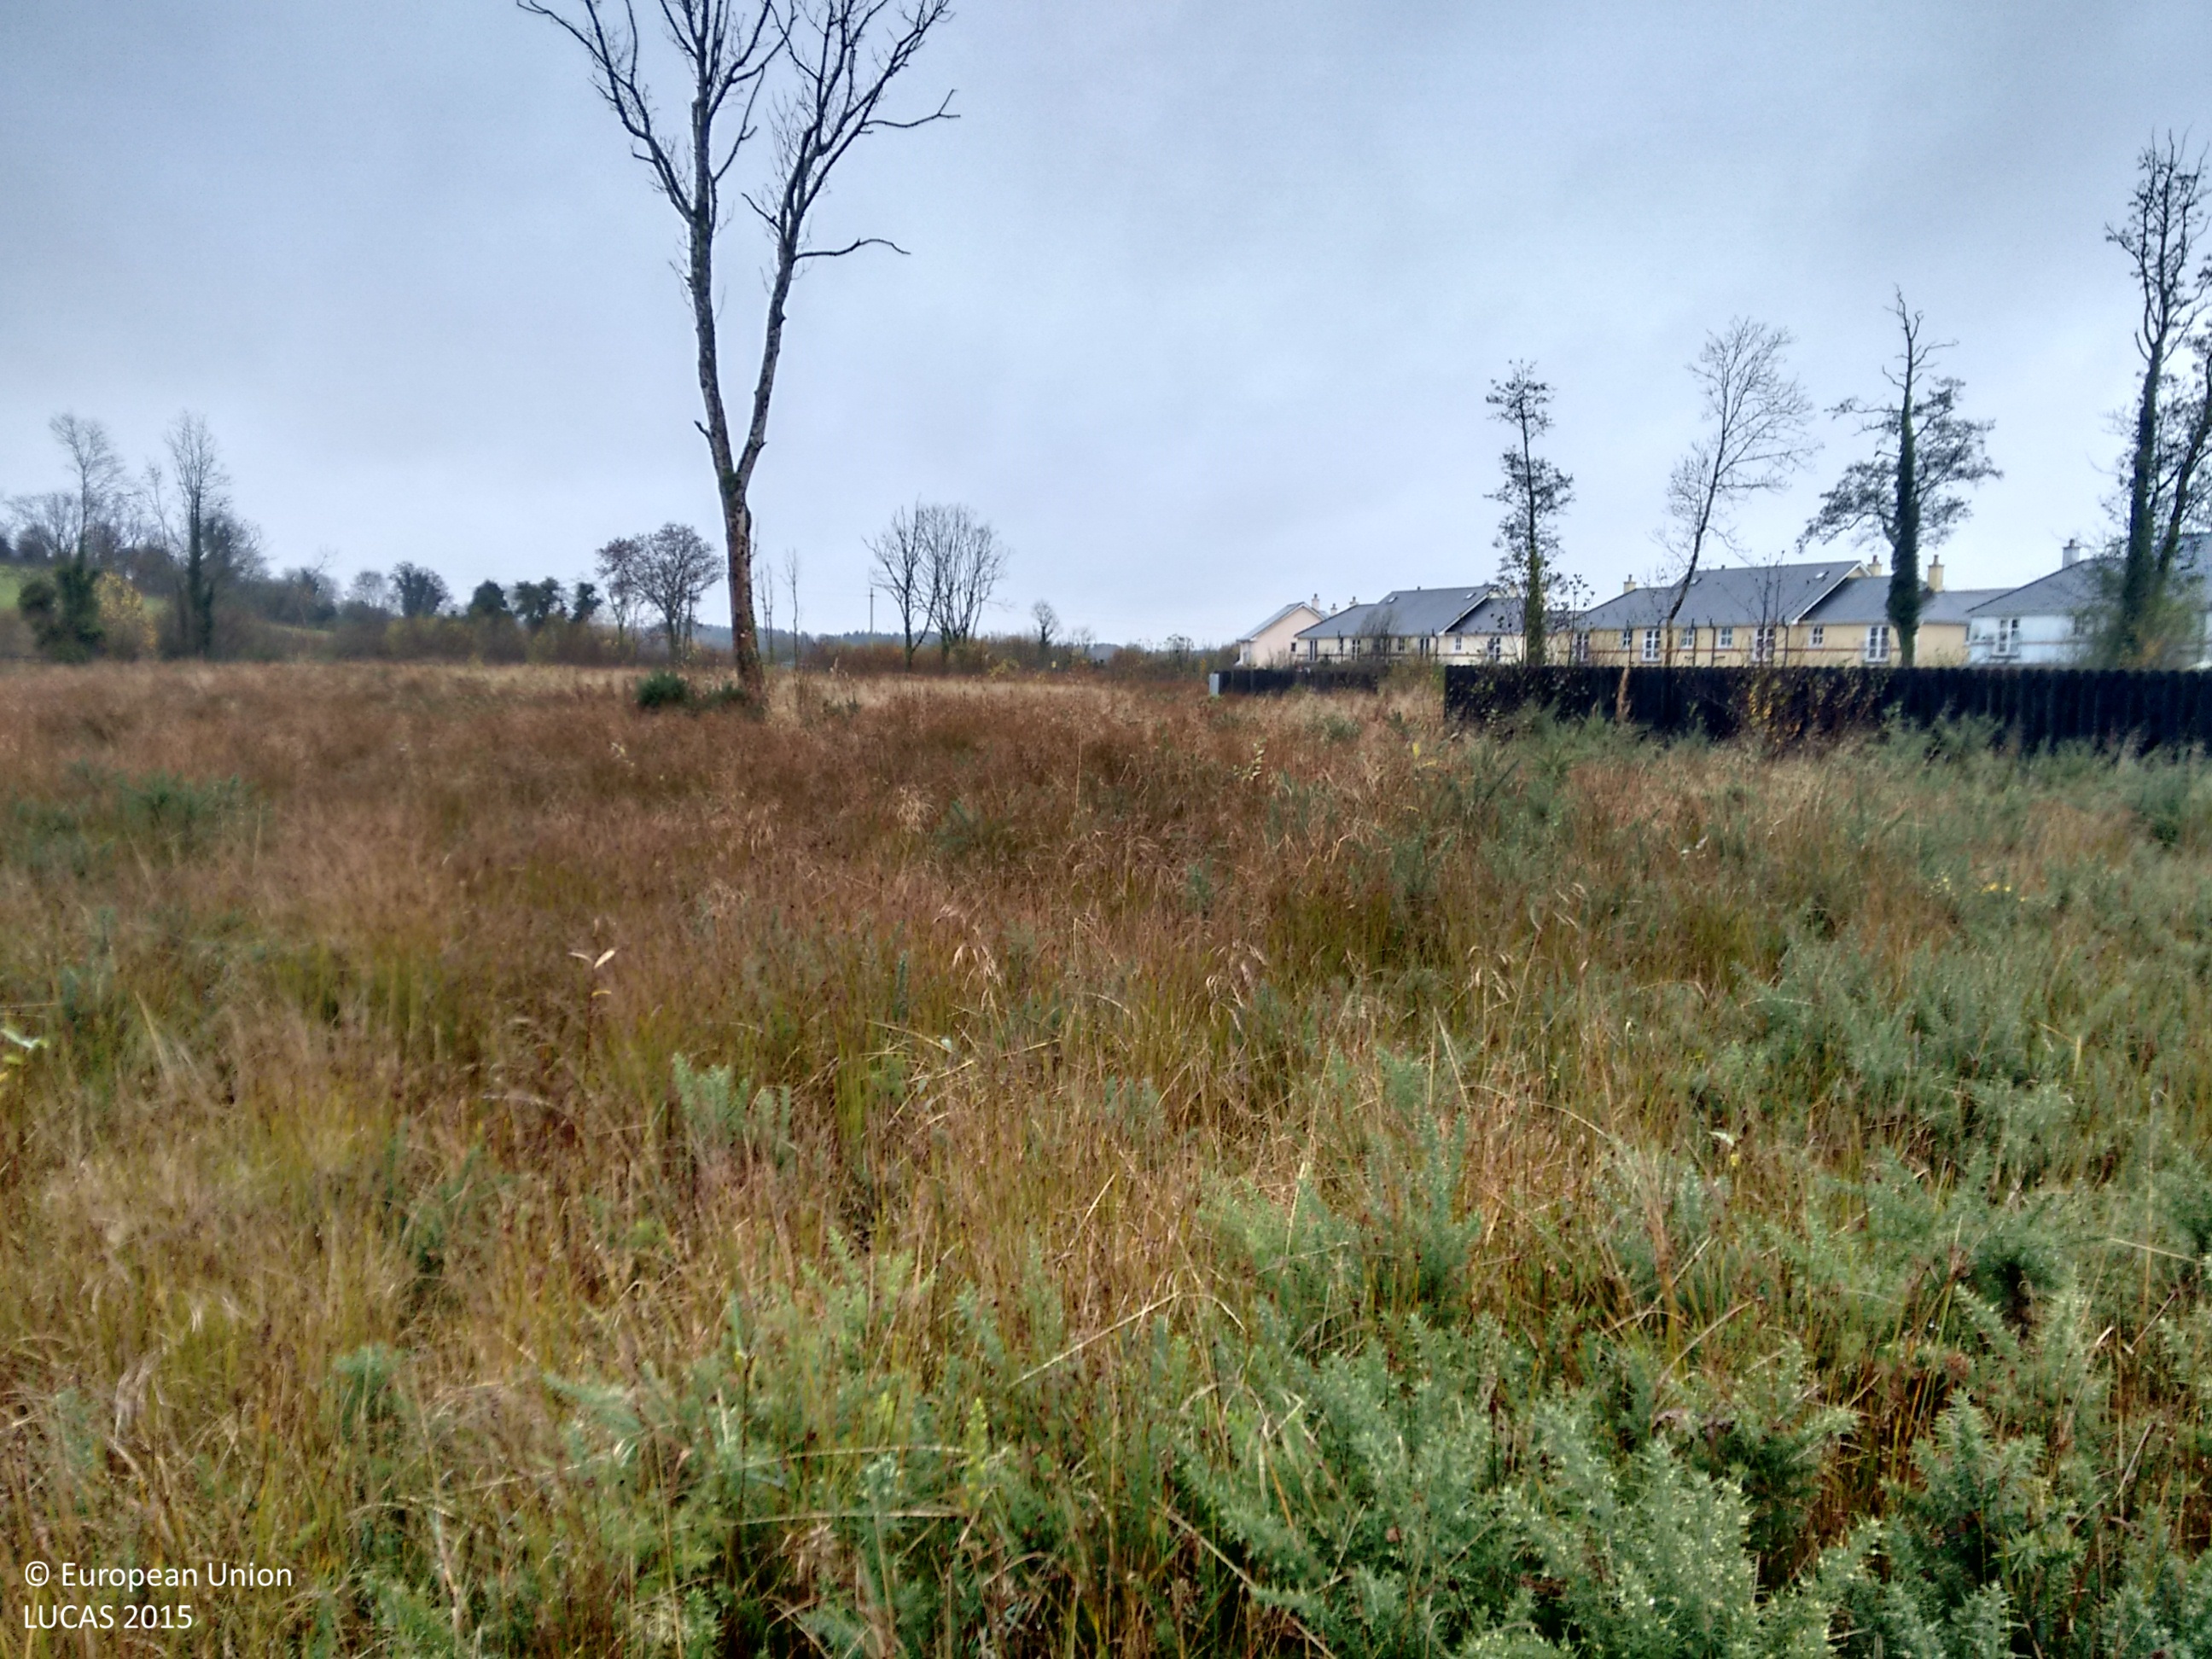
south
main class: Grassland
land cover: Spontaneously vegetated surfaces
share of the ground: > 75 %
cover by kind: herbaceous plants 95 %, shrubs 5 %
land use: Abandoned areas
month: November
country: IE
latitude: 53.8579
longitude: -7.9144
